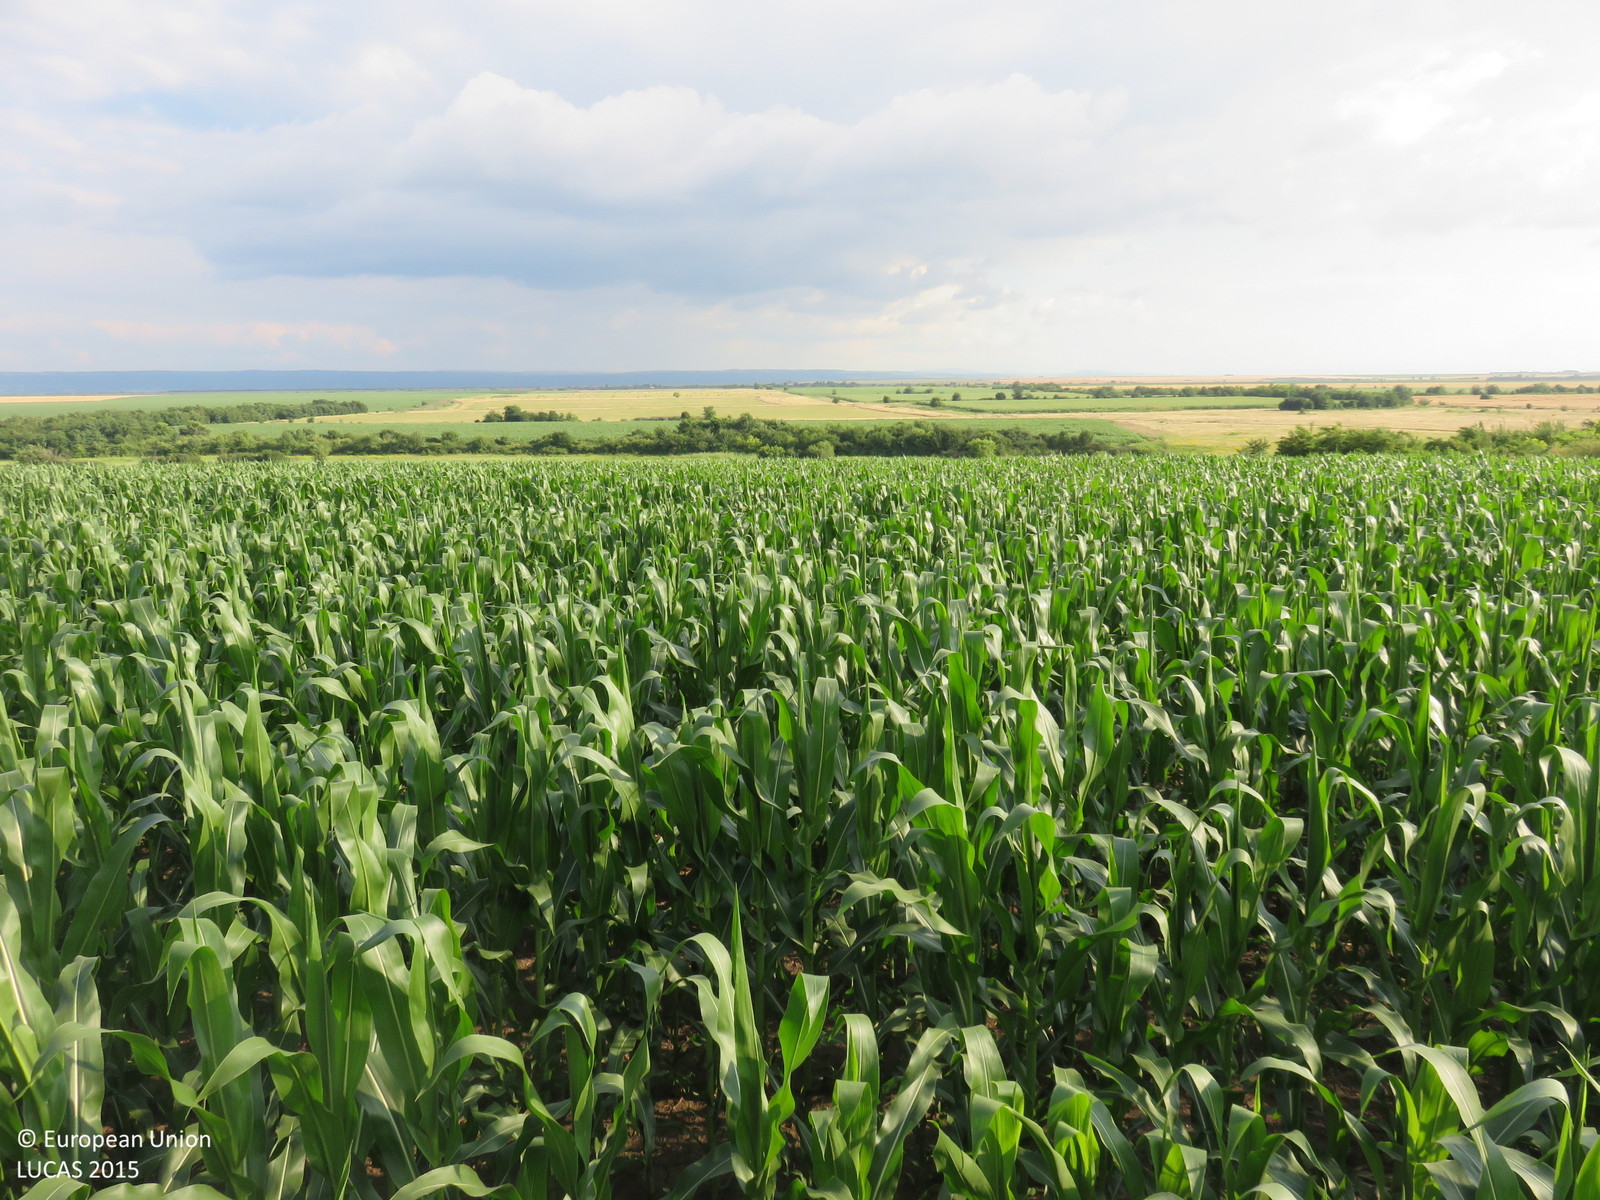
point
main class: Cropland
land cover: Maize
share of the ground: > 75 %
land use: Agriculture (excluding fallow land and kitchen gardens)
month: June
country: BG
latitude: 43.3717
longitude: 24.9400
